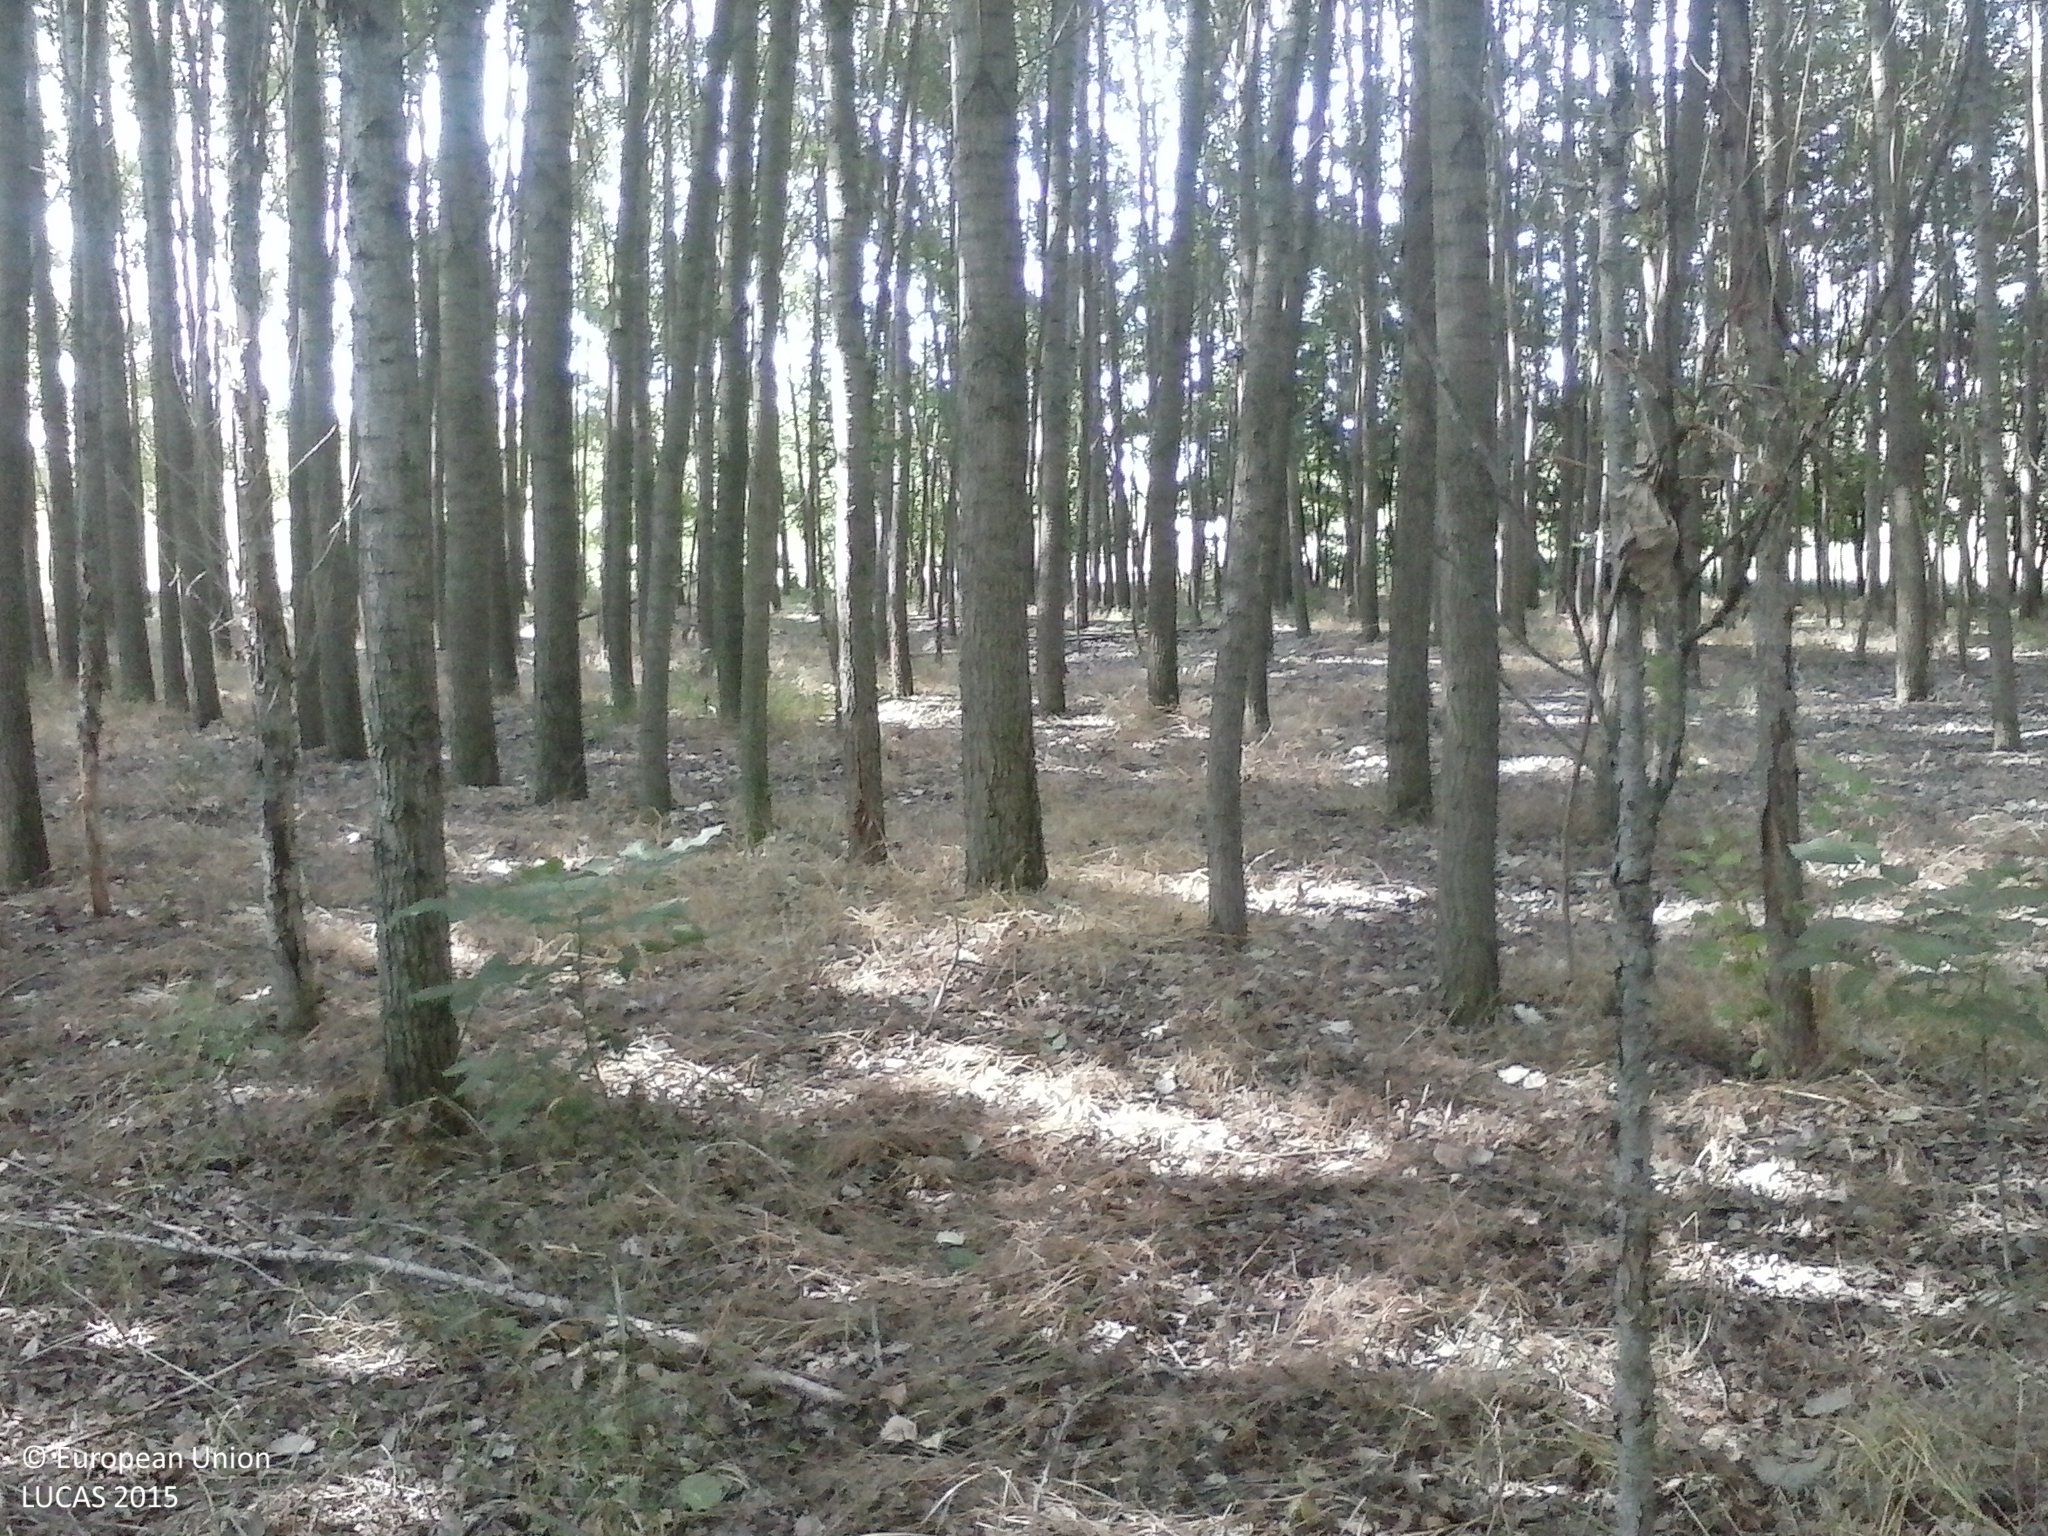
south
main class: Woodland
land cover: Broadleaved woodland
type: non-riverine alder, birch or aspen forest
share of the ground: > 75 %
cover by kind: broadleaved forest trees 90 %, herbaceous plants 5 %, unconsolidated bare surface 5 %
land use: Forestry
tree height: > 5 m
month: July
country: HU
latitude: 46.5658
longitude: 19.6600
